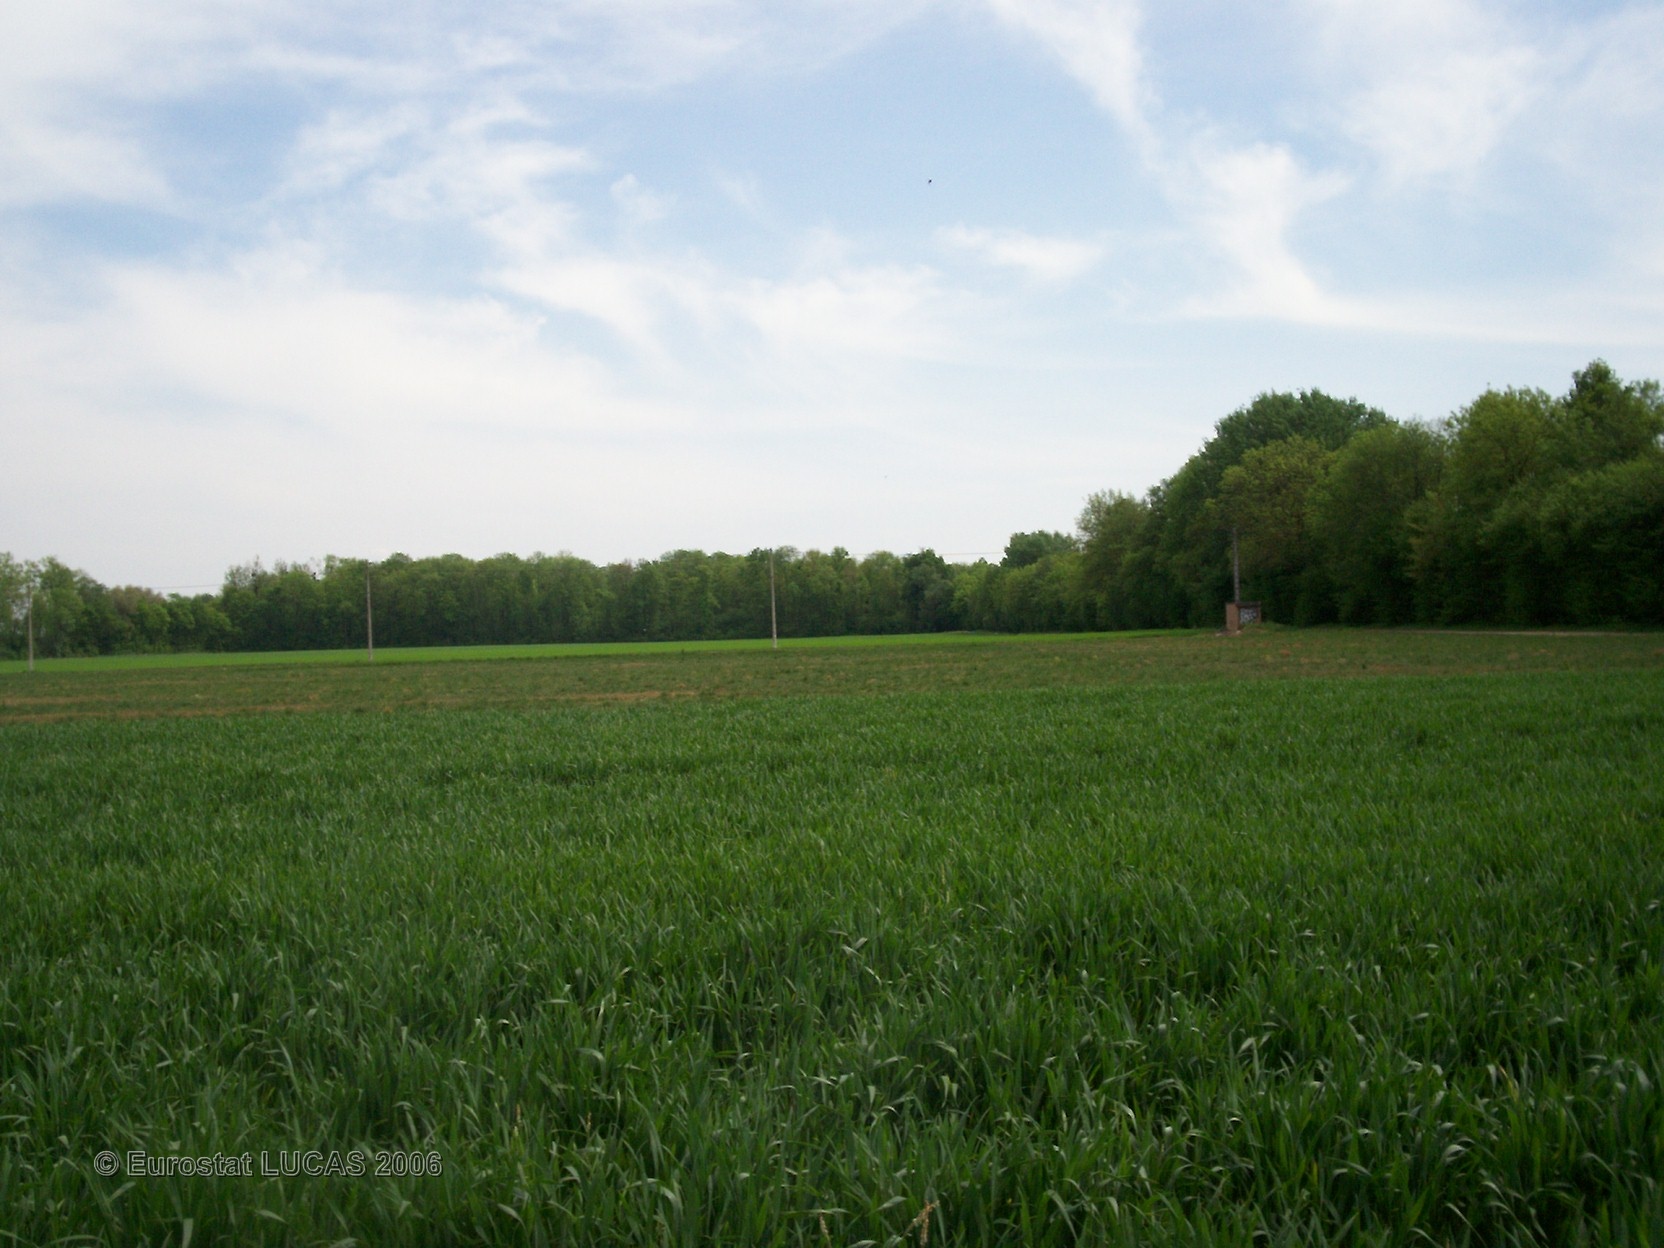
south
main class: Cropland
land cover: Common wheat
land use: Agriculture (excluding fallow land and kitchen gardens)
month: May
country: FR
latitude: 48.9282
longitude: 4.3866
